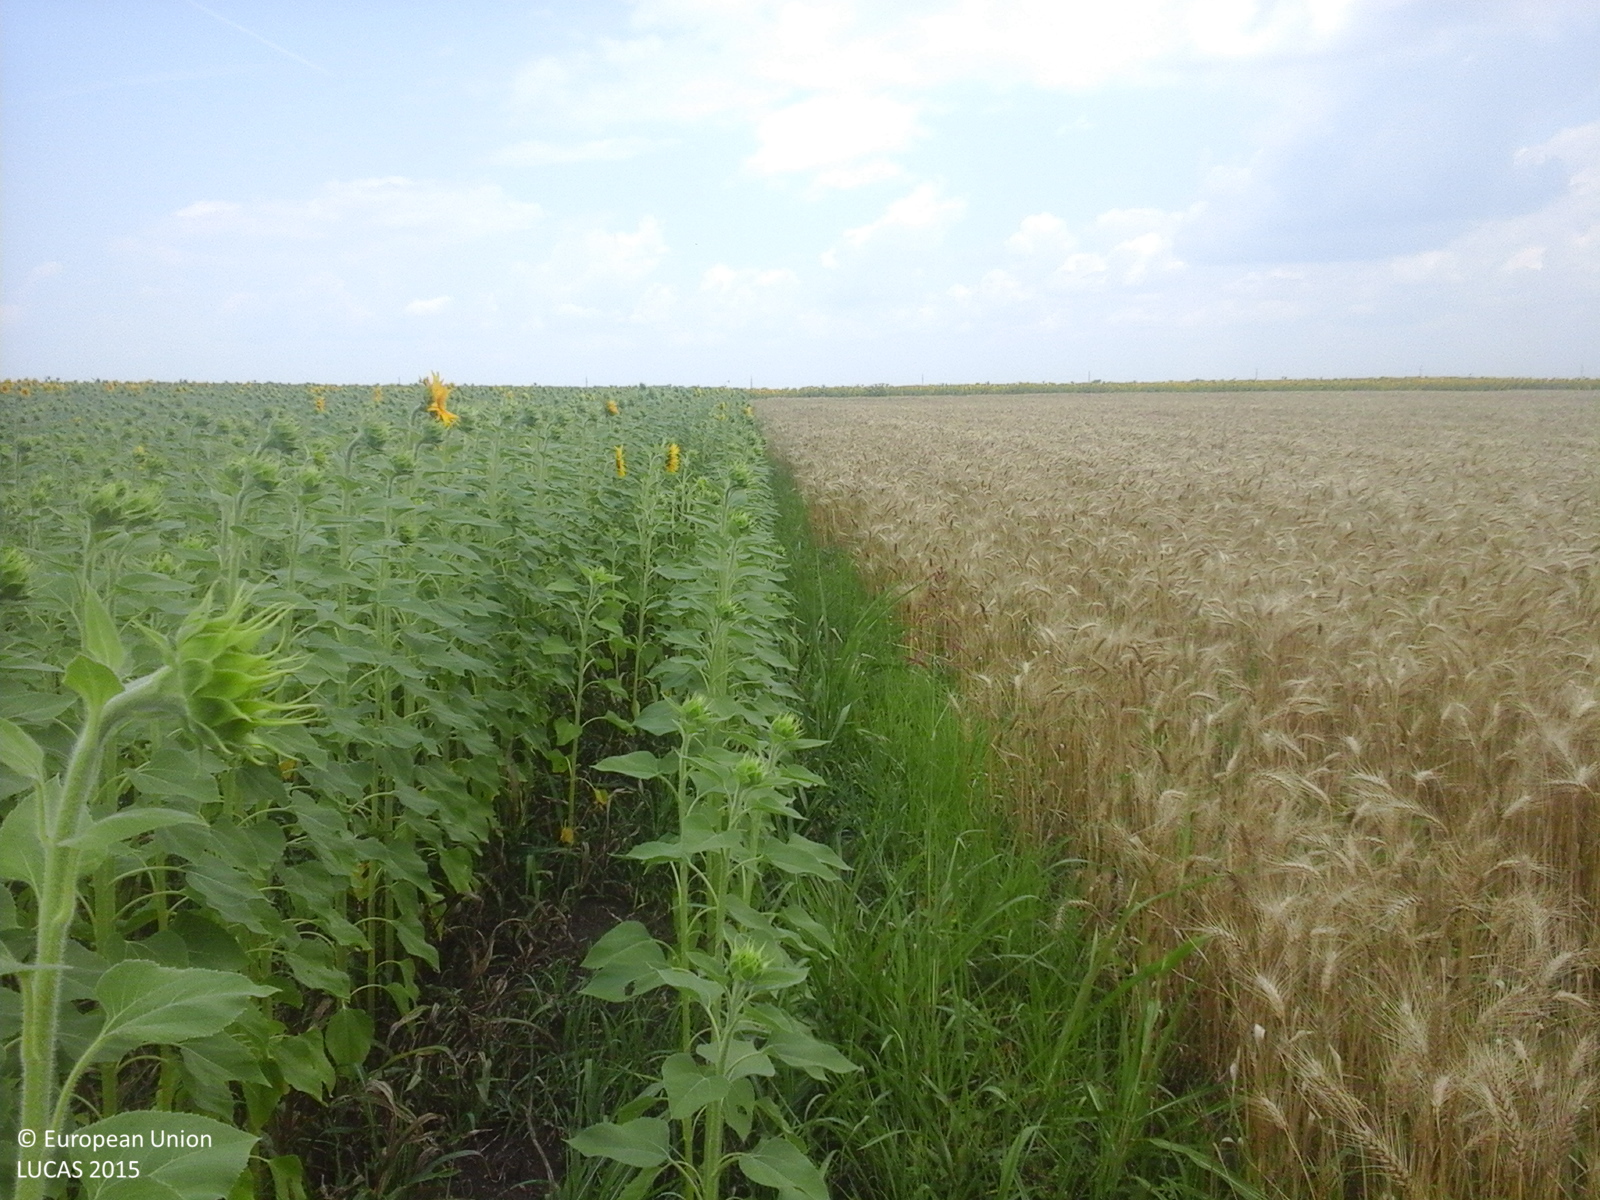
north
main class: Cropland
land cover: Sunflower
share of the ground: > 75 %
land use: Agriculture (excluding fallow land and kitchen gardens)
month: July
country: RO
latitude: 43.8902
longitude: 25.6362
